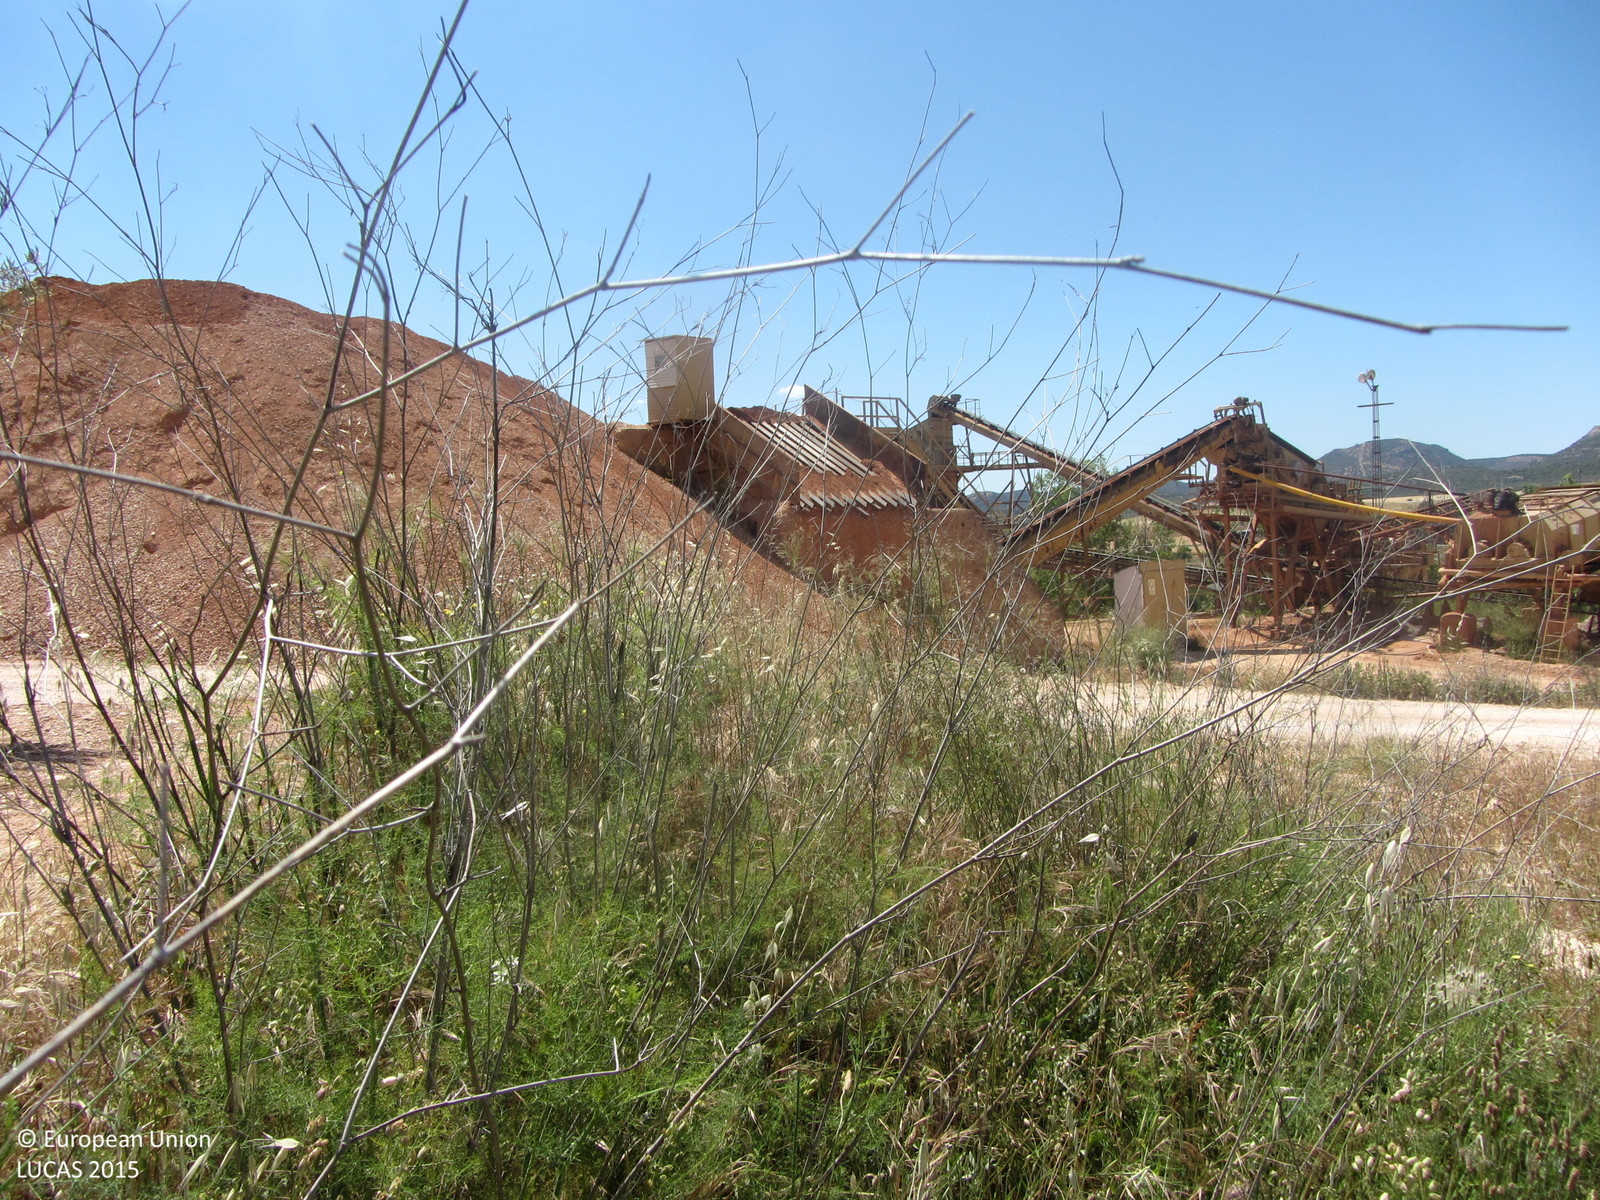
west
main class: Grassland
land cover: Grassland without tree/shrub cover
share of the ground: 50 - 75 %
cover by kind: herbaceous plants 65 %, consolidated bare surface 20 %, shrubs 5 %
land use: Mining and quarrying
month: May
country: ES
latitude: 38.3325
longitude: -2.8929
